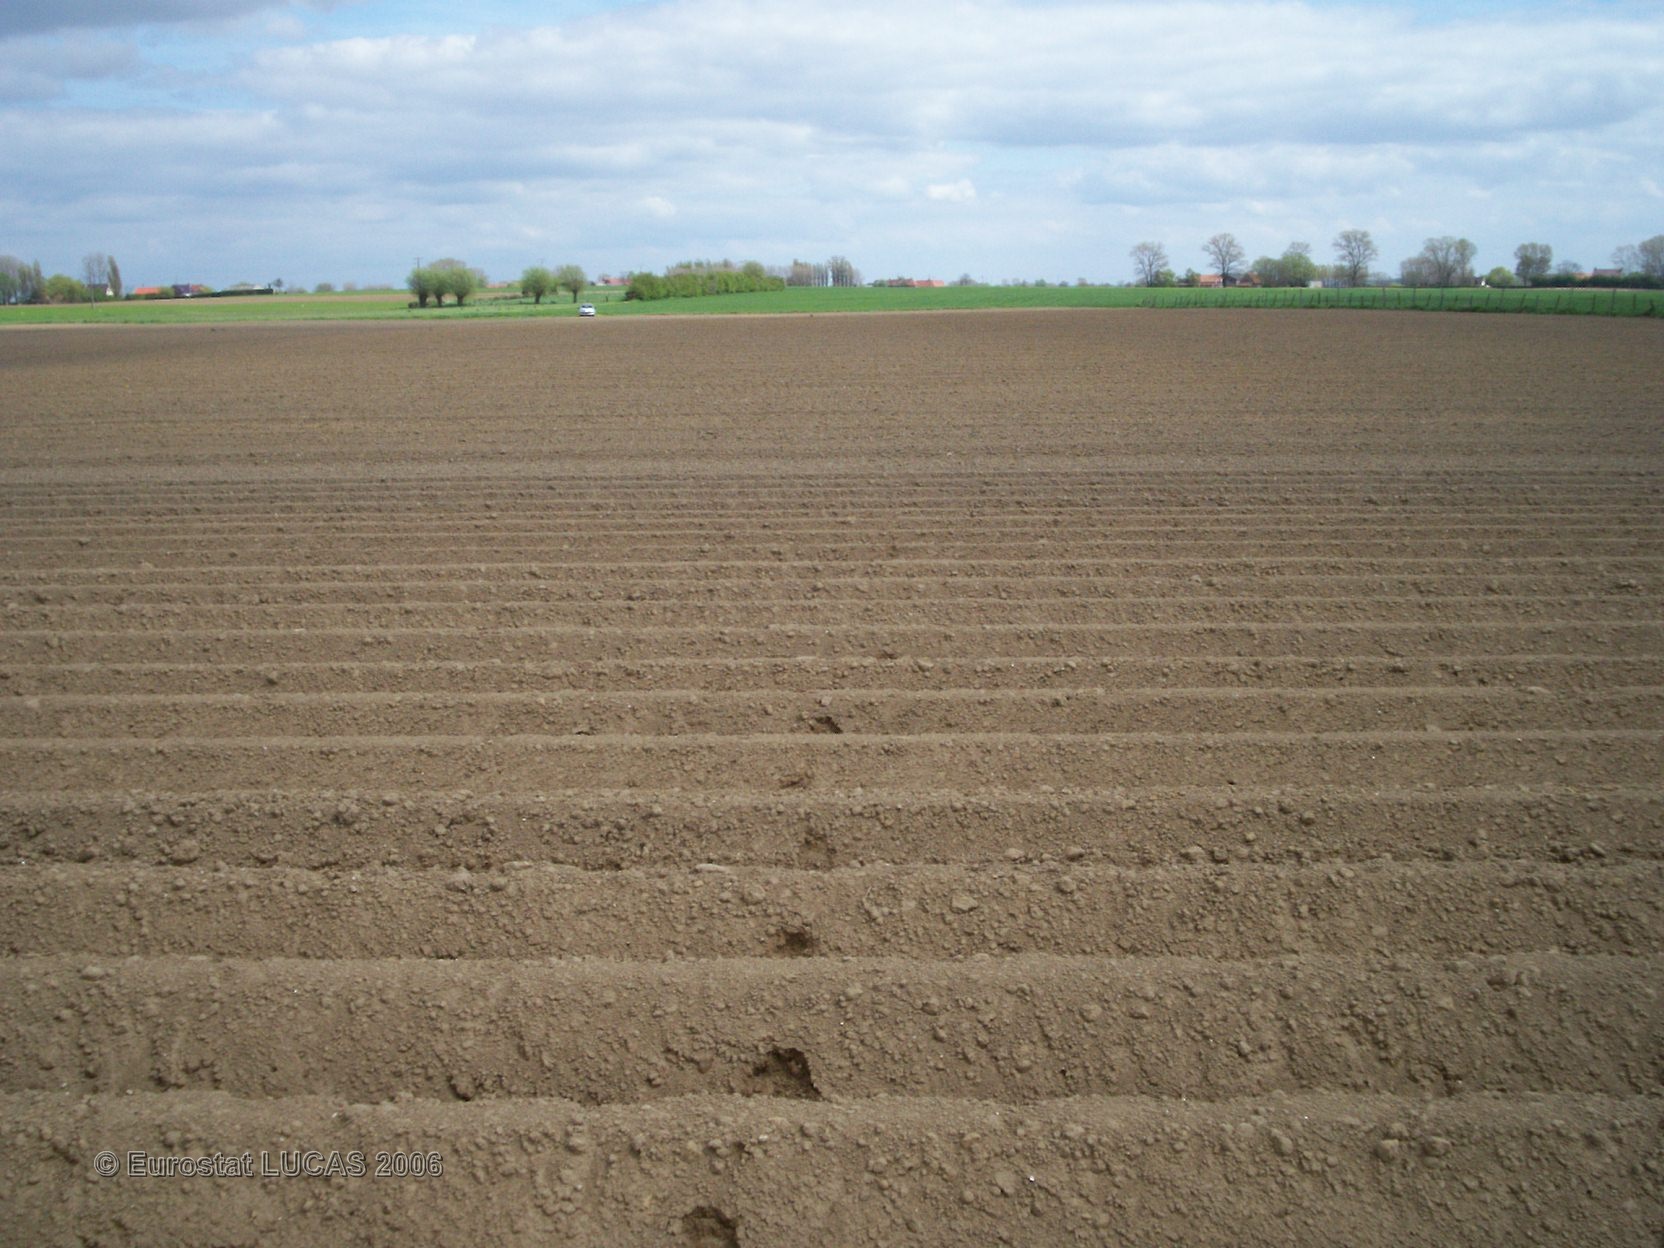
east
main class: Cropland
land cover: Potatoes
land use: Agriculture (excluding fallow land and kitchen gardens)
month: May
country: FR
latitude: 50.9154
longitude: 2.5485
